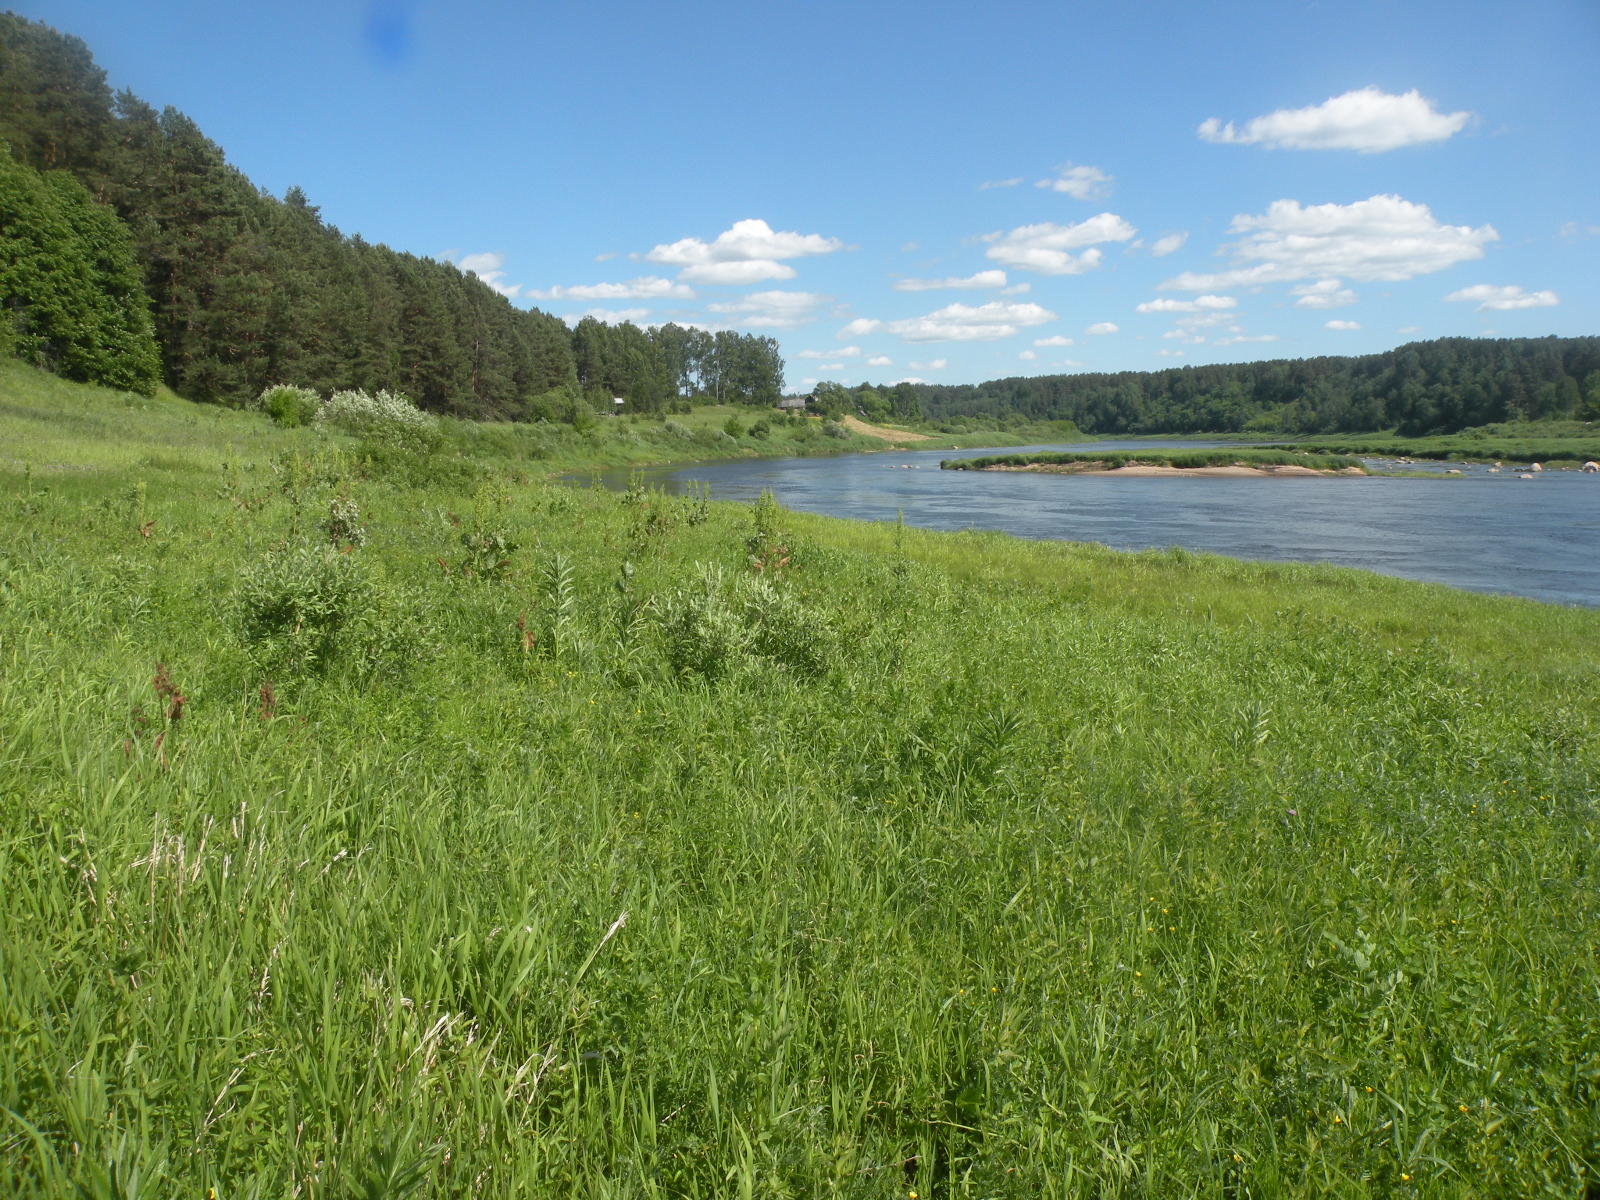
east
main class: Grassland
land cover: Spontaneously vegetated surfaces
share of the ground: > 75 %
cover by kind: herbaceous plants 100 %
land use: Semi-natural and natural areas not in use
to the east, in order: Spontaneously vegetated surfaces; Inland fresh running water
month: June
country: LV
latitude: 55.8705
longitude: 26.9941
